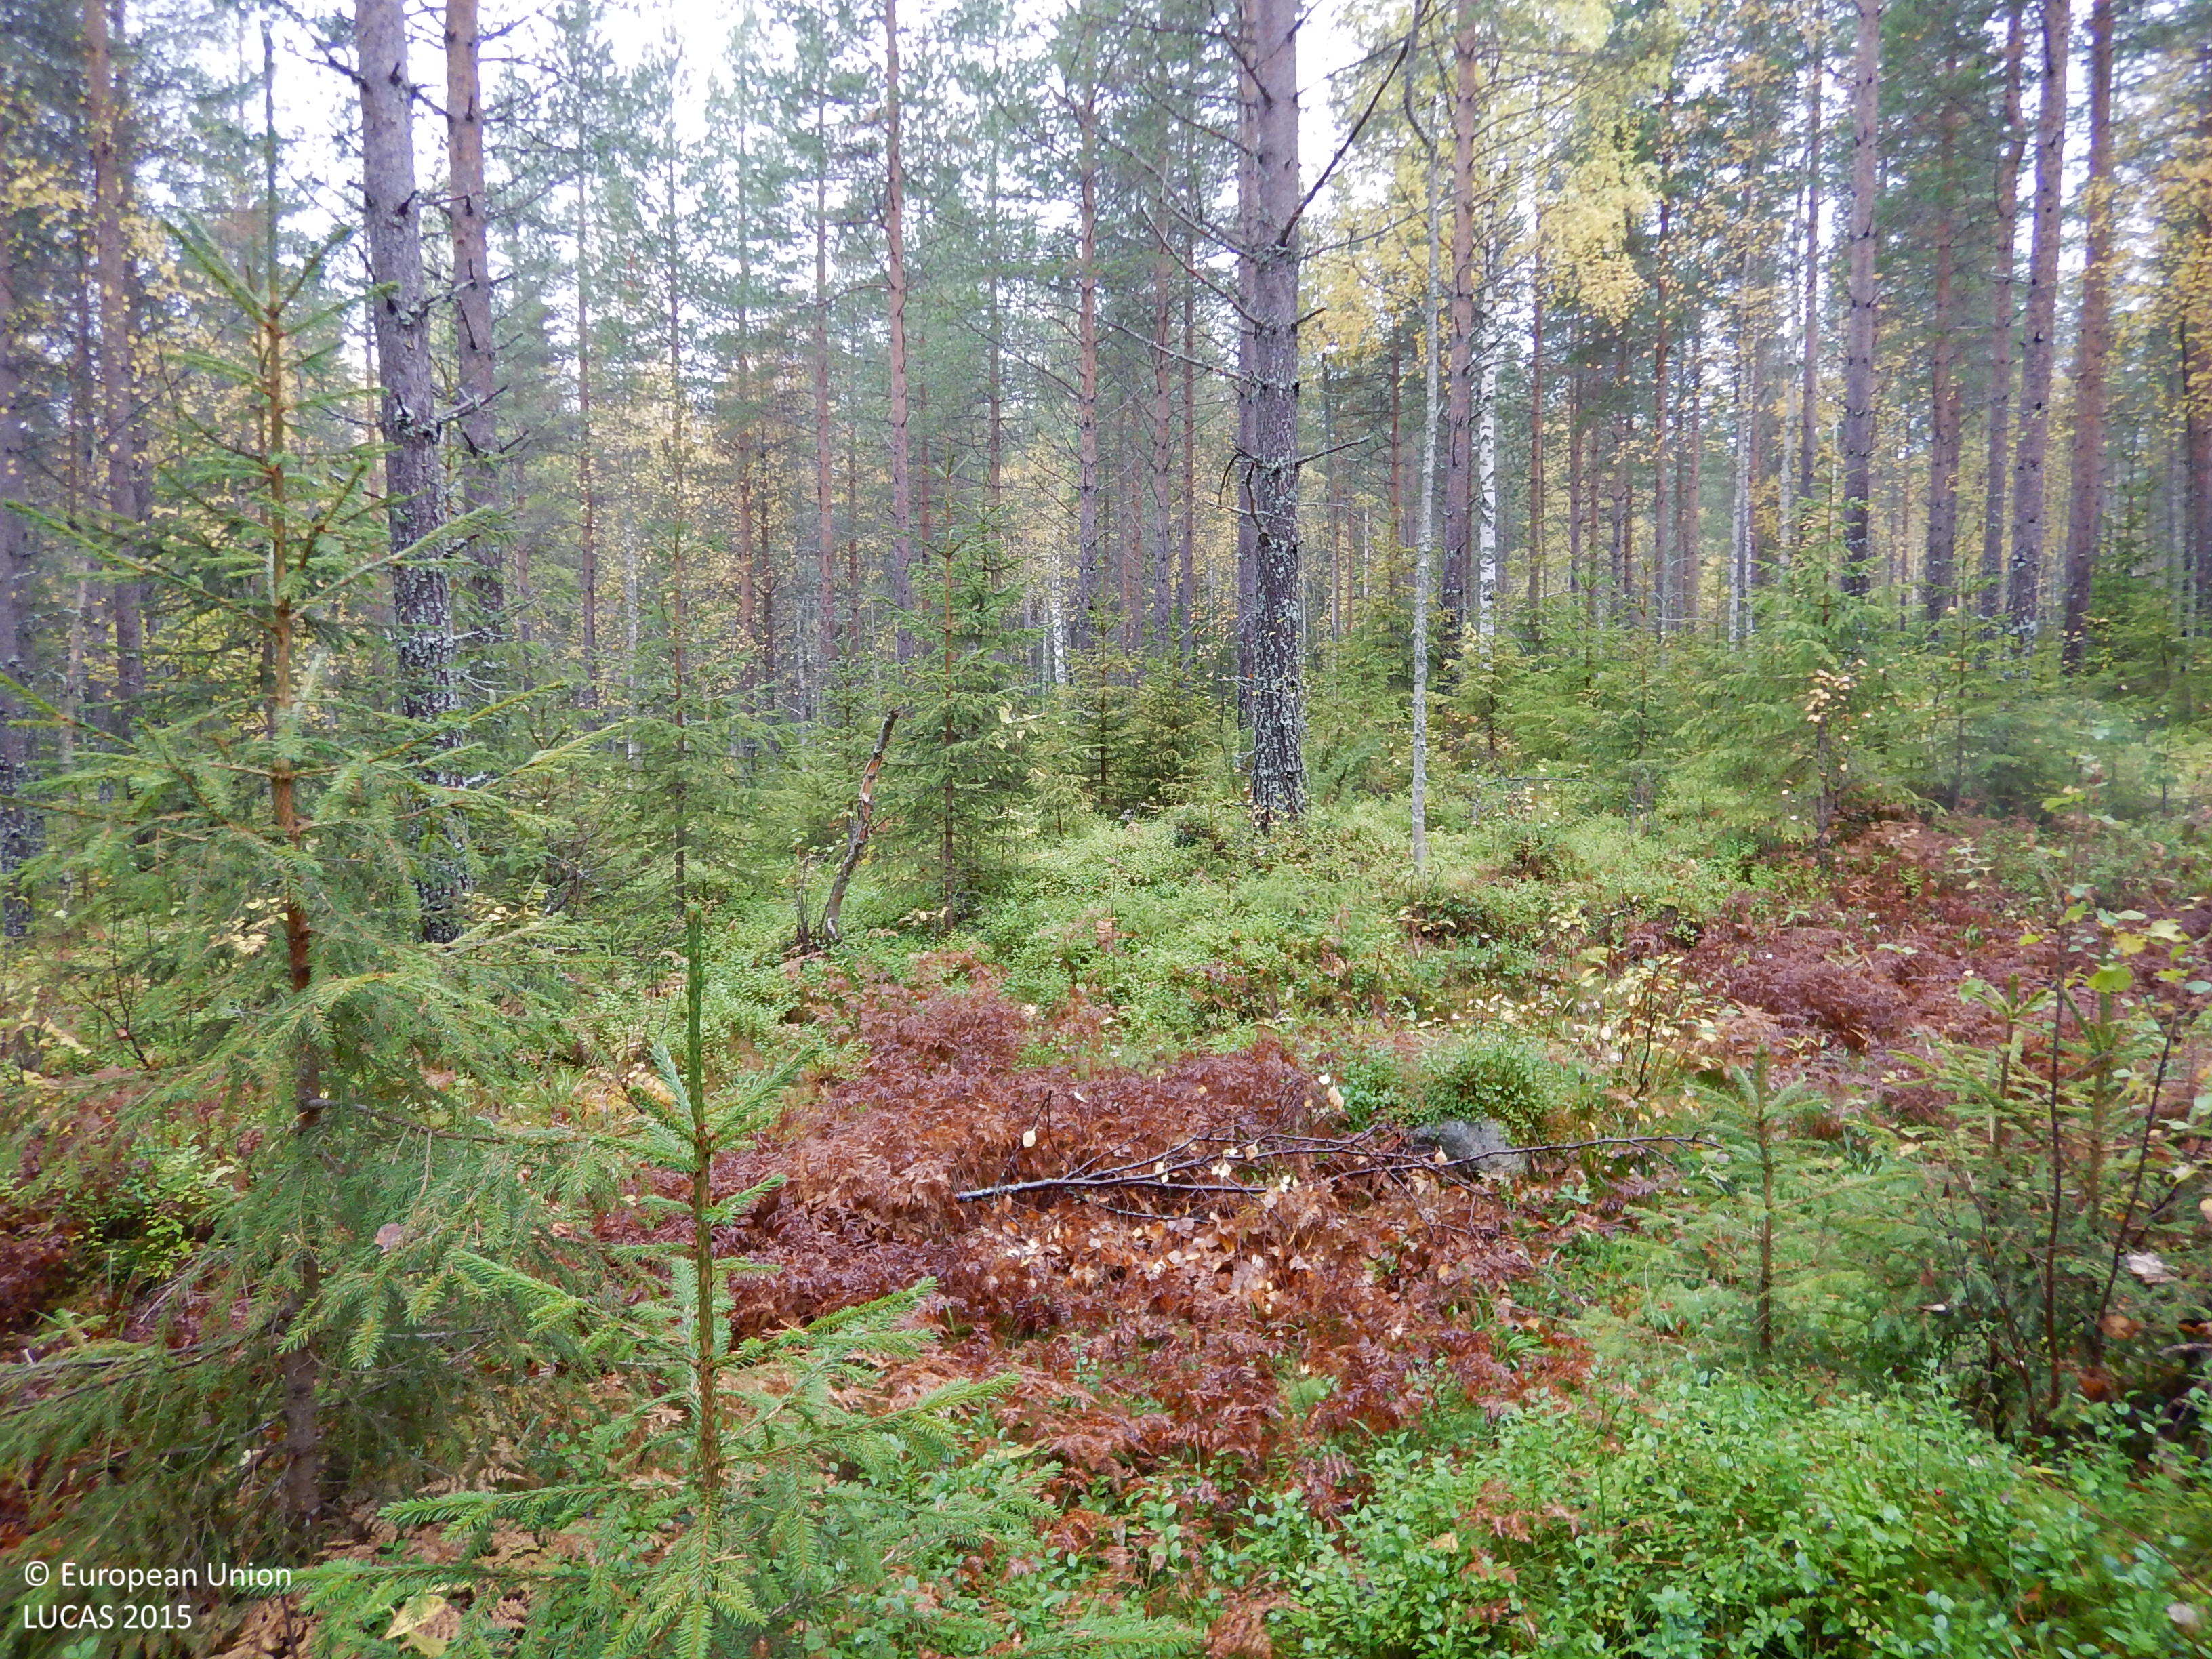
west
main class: Woodland
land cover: Pine dominated coniferous woodland
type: boreal forest
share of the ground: 50 - 75 %
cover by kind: coniferous forest trees 60 %, shrubs 15 %, herbaceous plants 10 %, lichens and mosses 10 %, broadleaved forest trees 5 %
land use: Forestry
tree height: > 5 m
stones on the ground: < 10 %
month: September
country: SE
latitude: 64.9753
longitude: 19.3952
